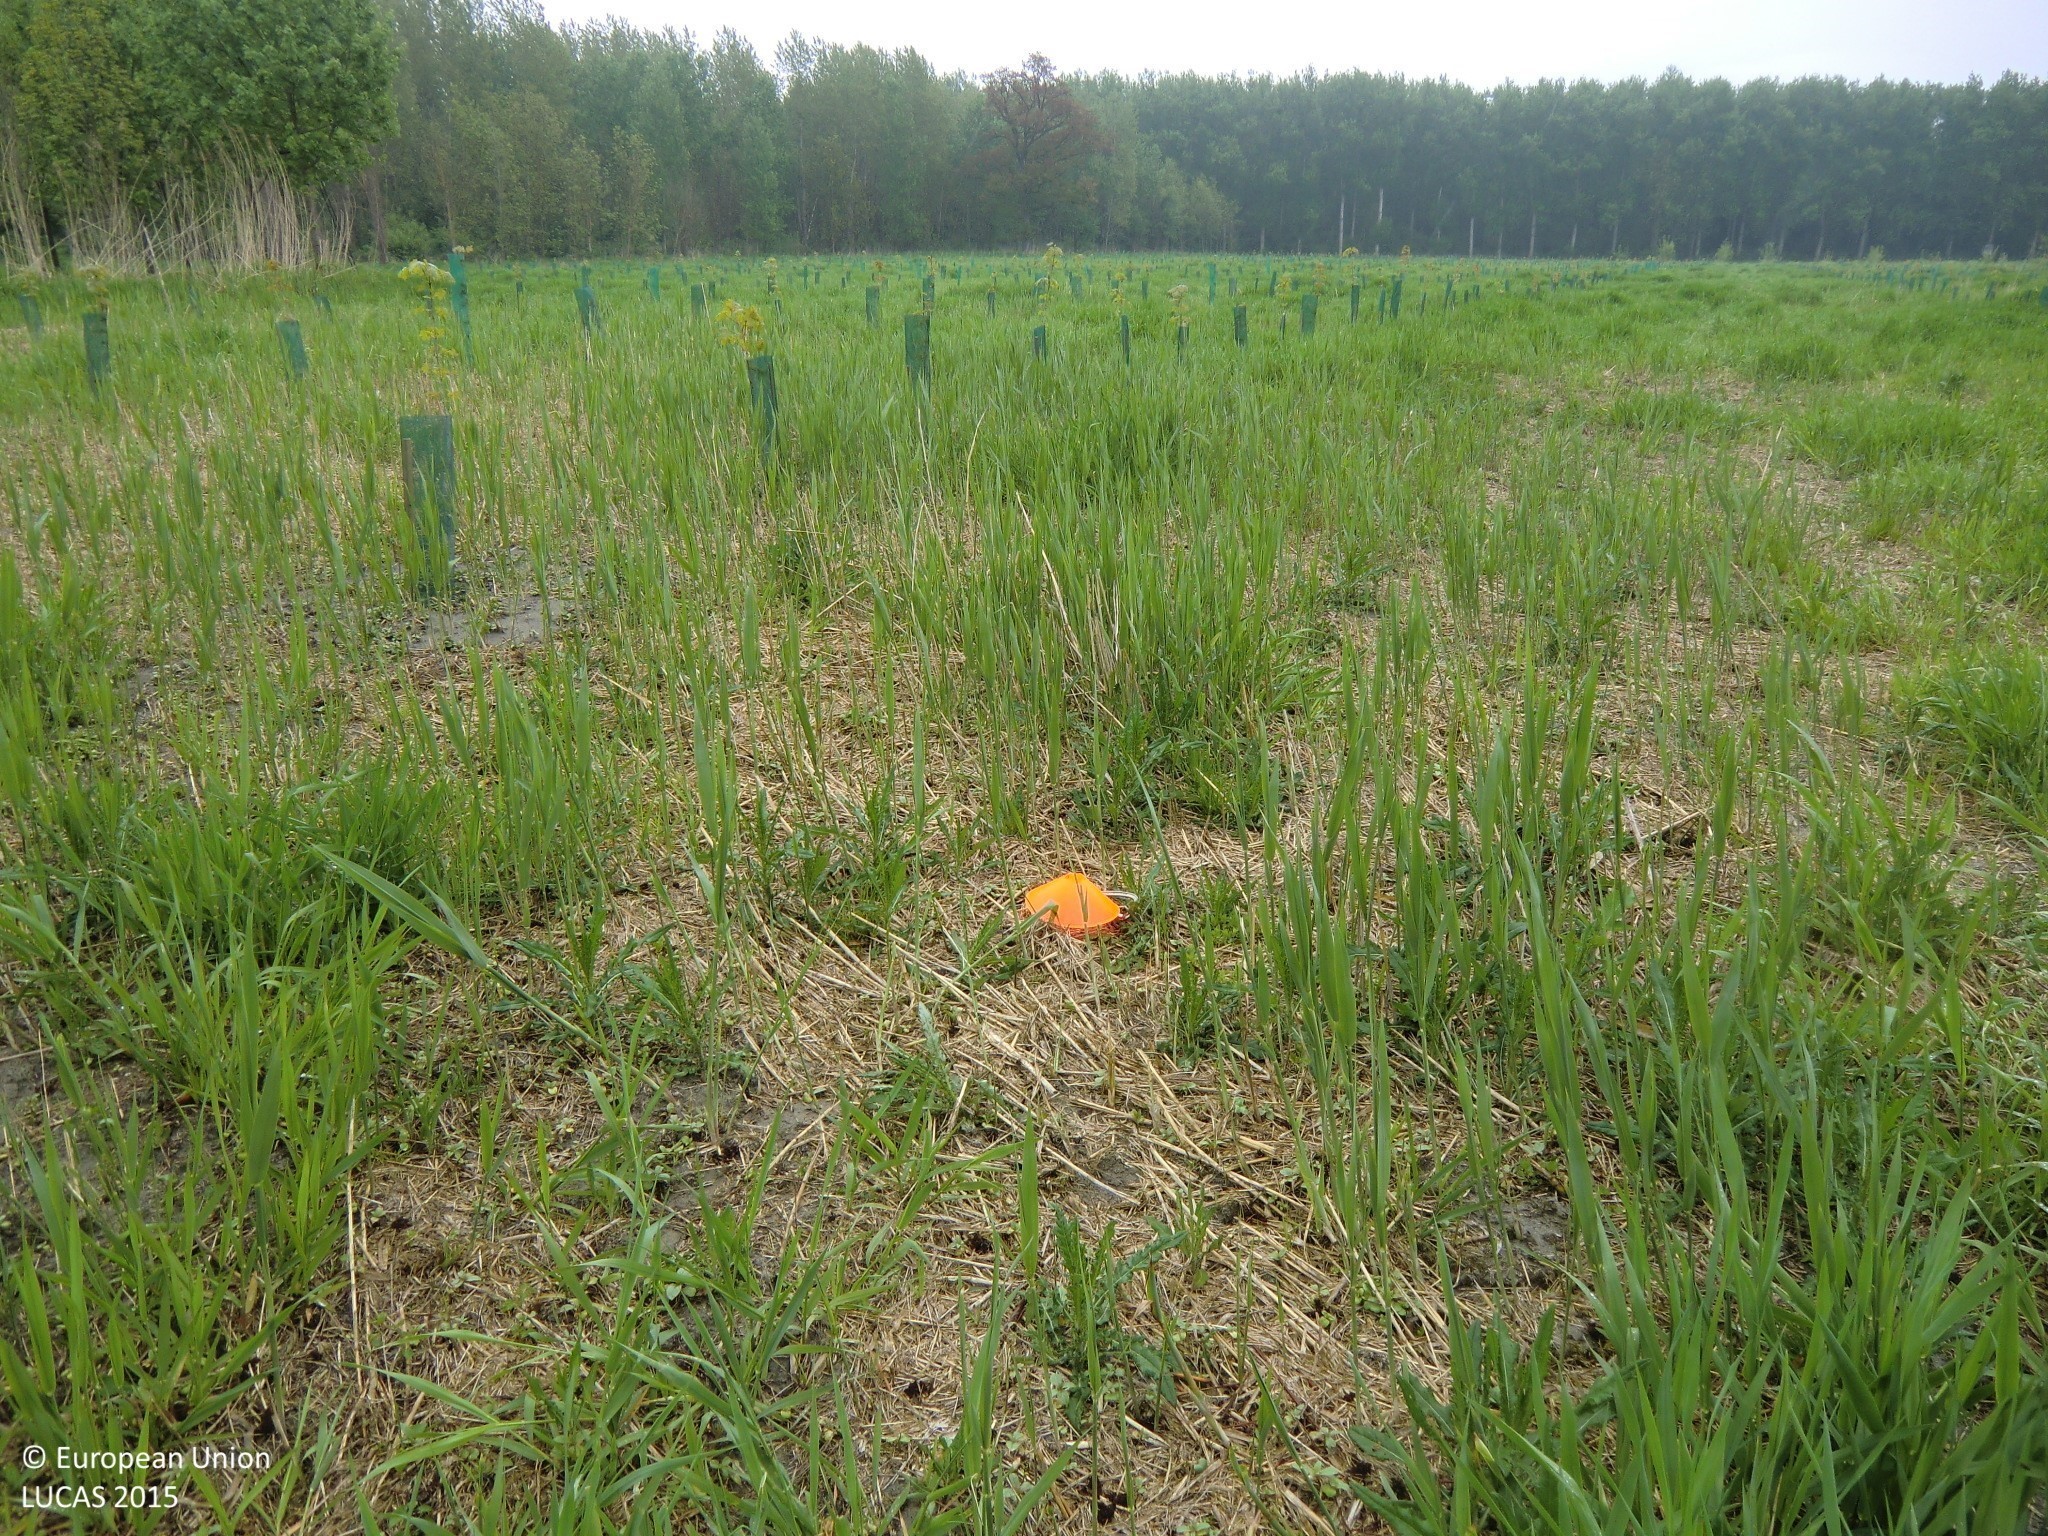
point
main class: Cropland
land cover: Nurseries
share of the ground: < 10 %
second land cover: Spontaneously vegetated surfaces
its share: > 75 %
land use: Forestry
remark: Temporary flooded
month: May
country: AT
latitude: 48.1765
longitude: 14.7210
